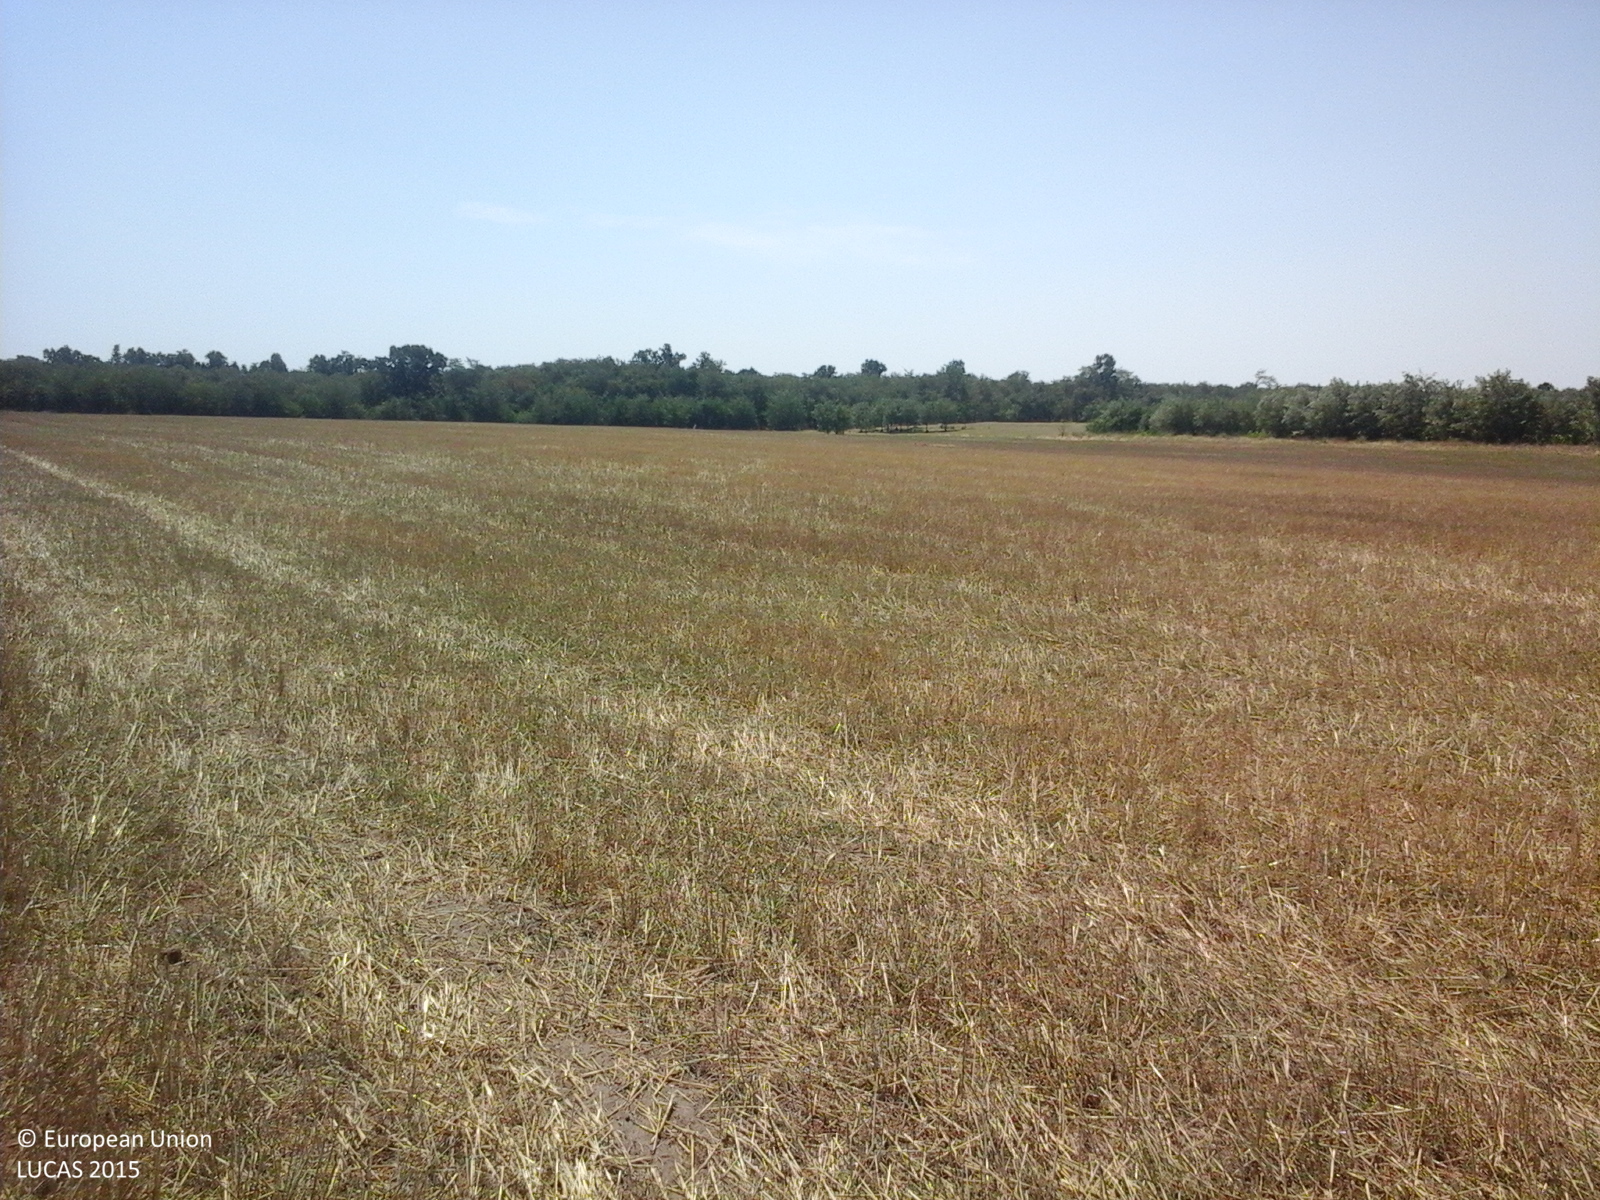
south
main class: Cropland
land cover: Barley
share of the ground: > 75 %
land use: Agriculture (excluding fallow land and kitchen gardens)
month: August
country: RO
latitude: 45.7552
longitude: 27.5250
